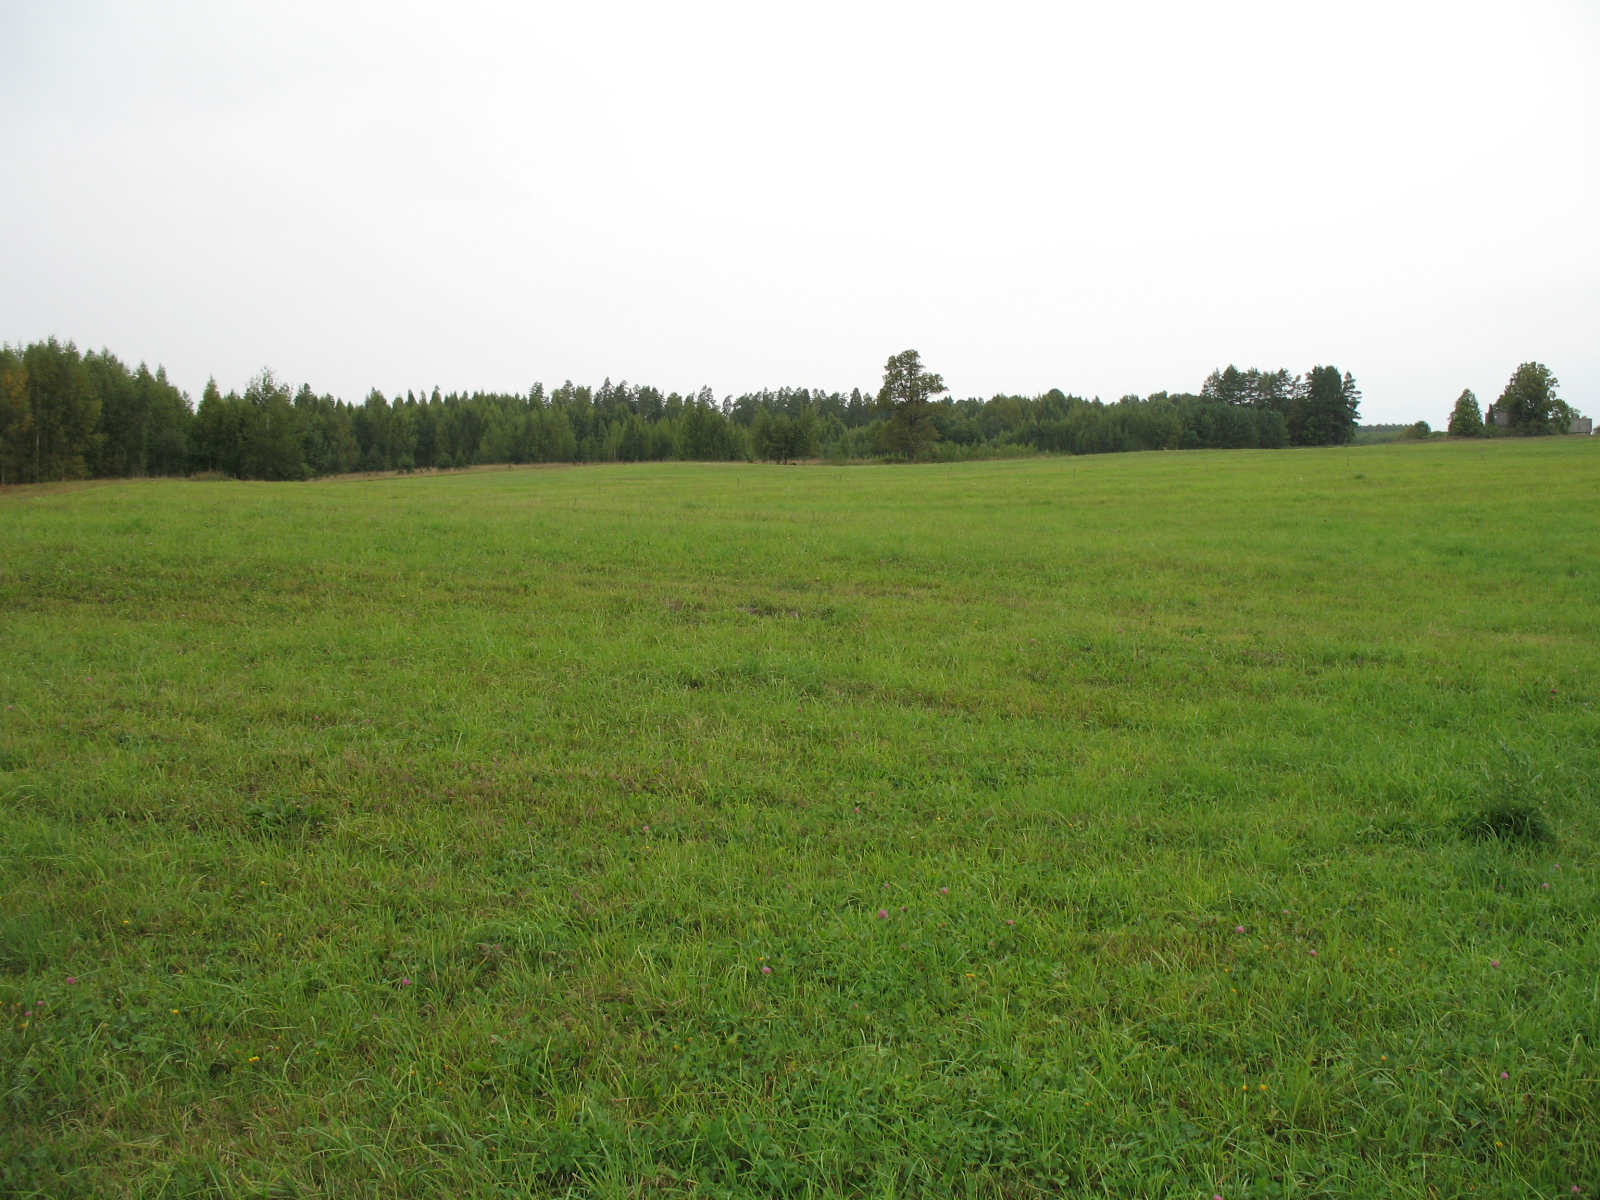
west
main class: Grassland
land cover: Grassland without tree/shrub cover
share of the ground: > 75 %
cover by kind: herbaceous plants 100 %
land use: Agriculture (excluding fallow land and kitchen gardens)
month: September
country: LV
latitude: 56.1990
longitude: 26.1771
